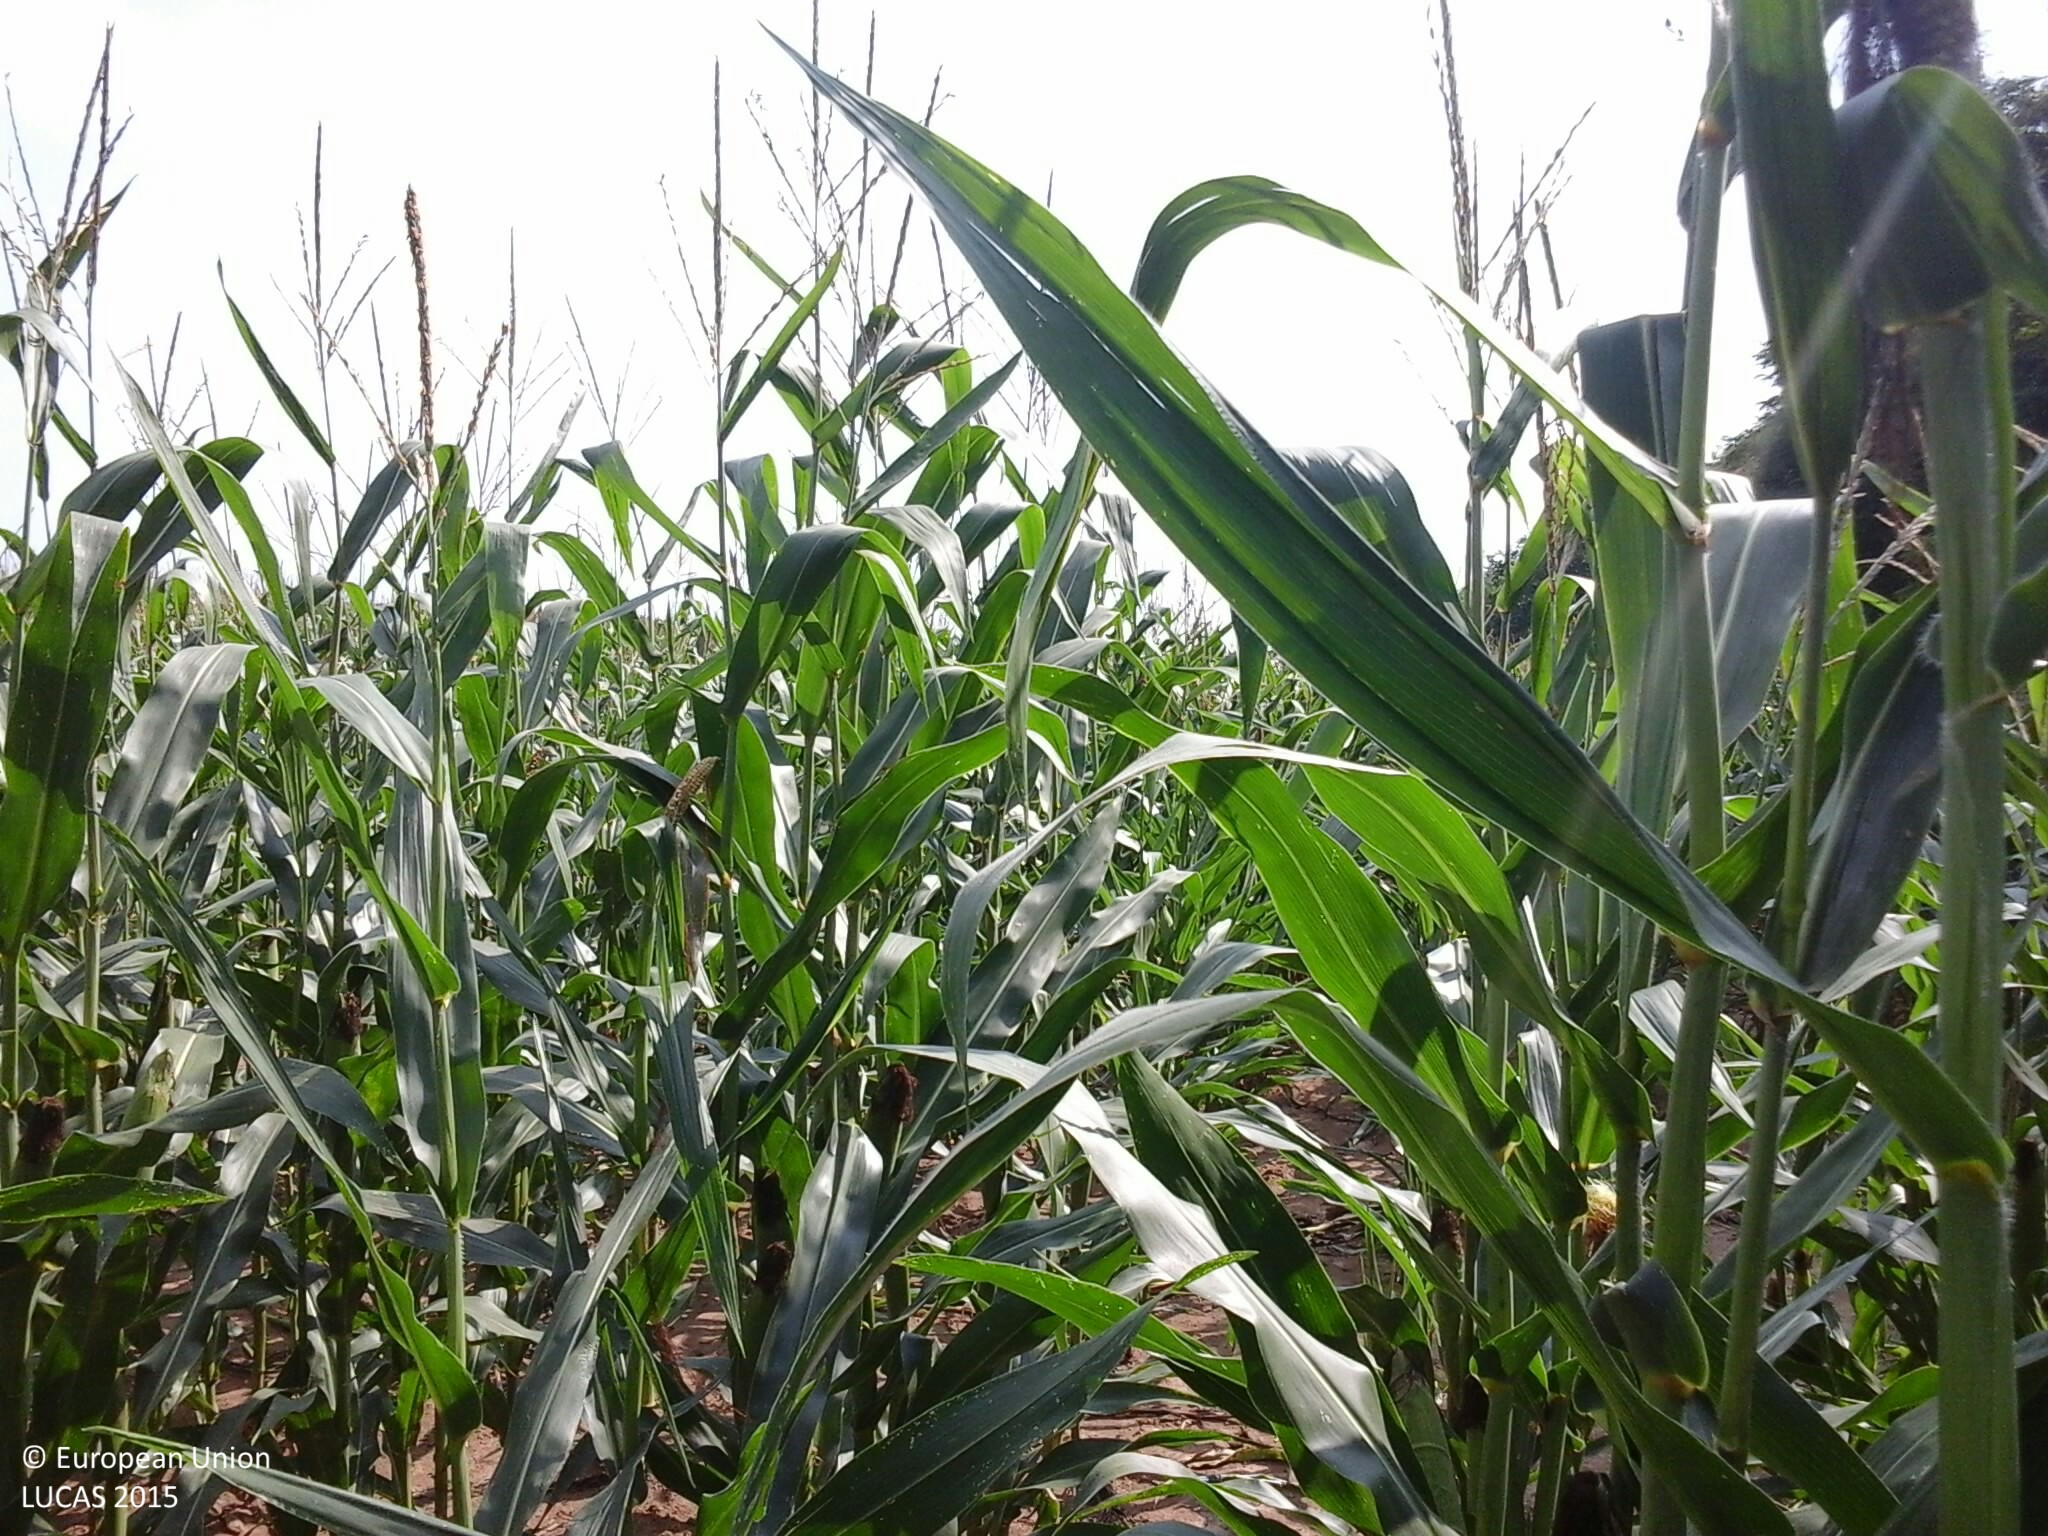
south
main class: Cropland
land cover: Maize
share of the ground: > 75 %
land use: Agriculture (excluding fallow land and kitchen gardens)
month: August
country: HU
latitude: 45.9138
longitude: 18.1412
